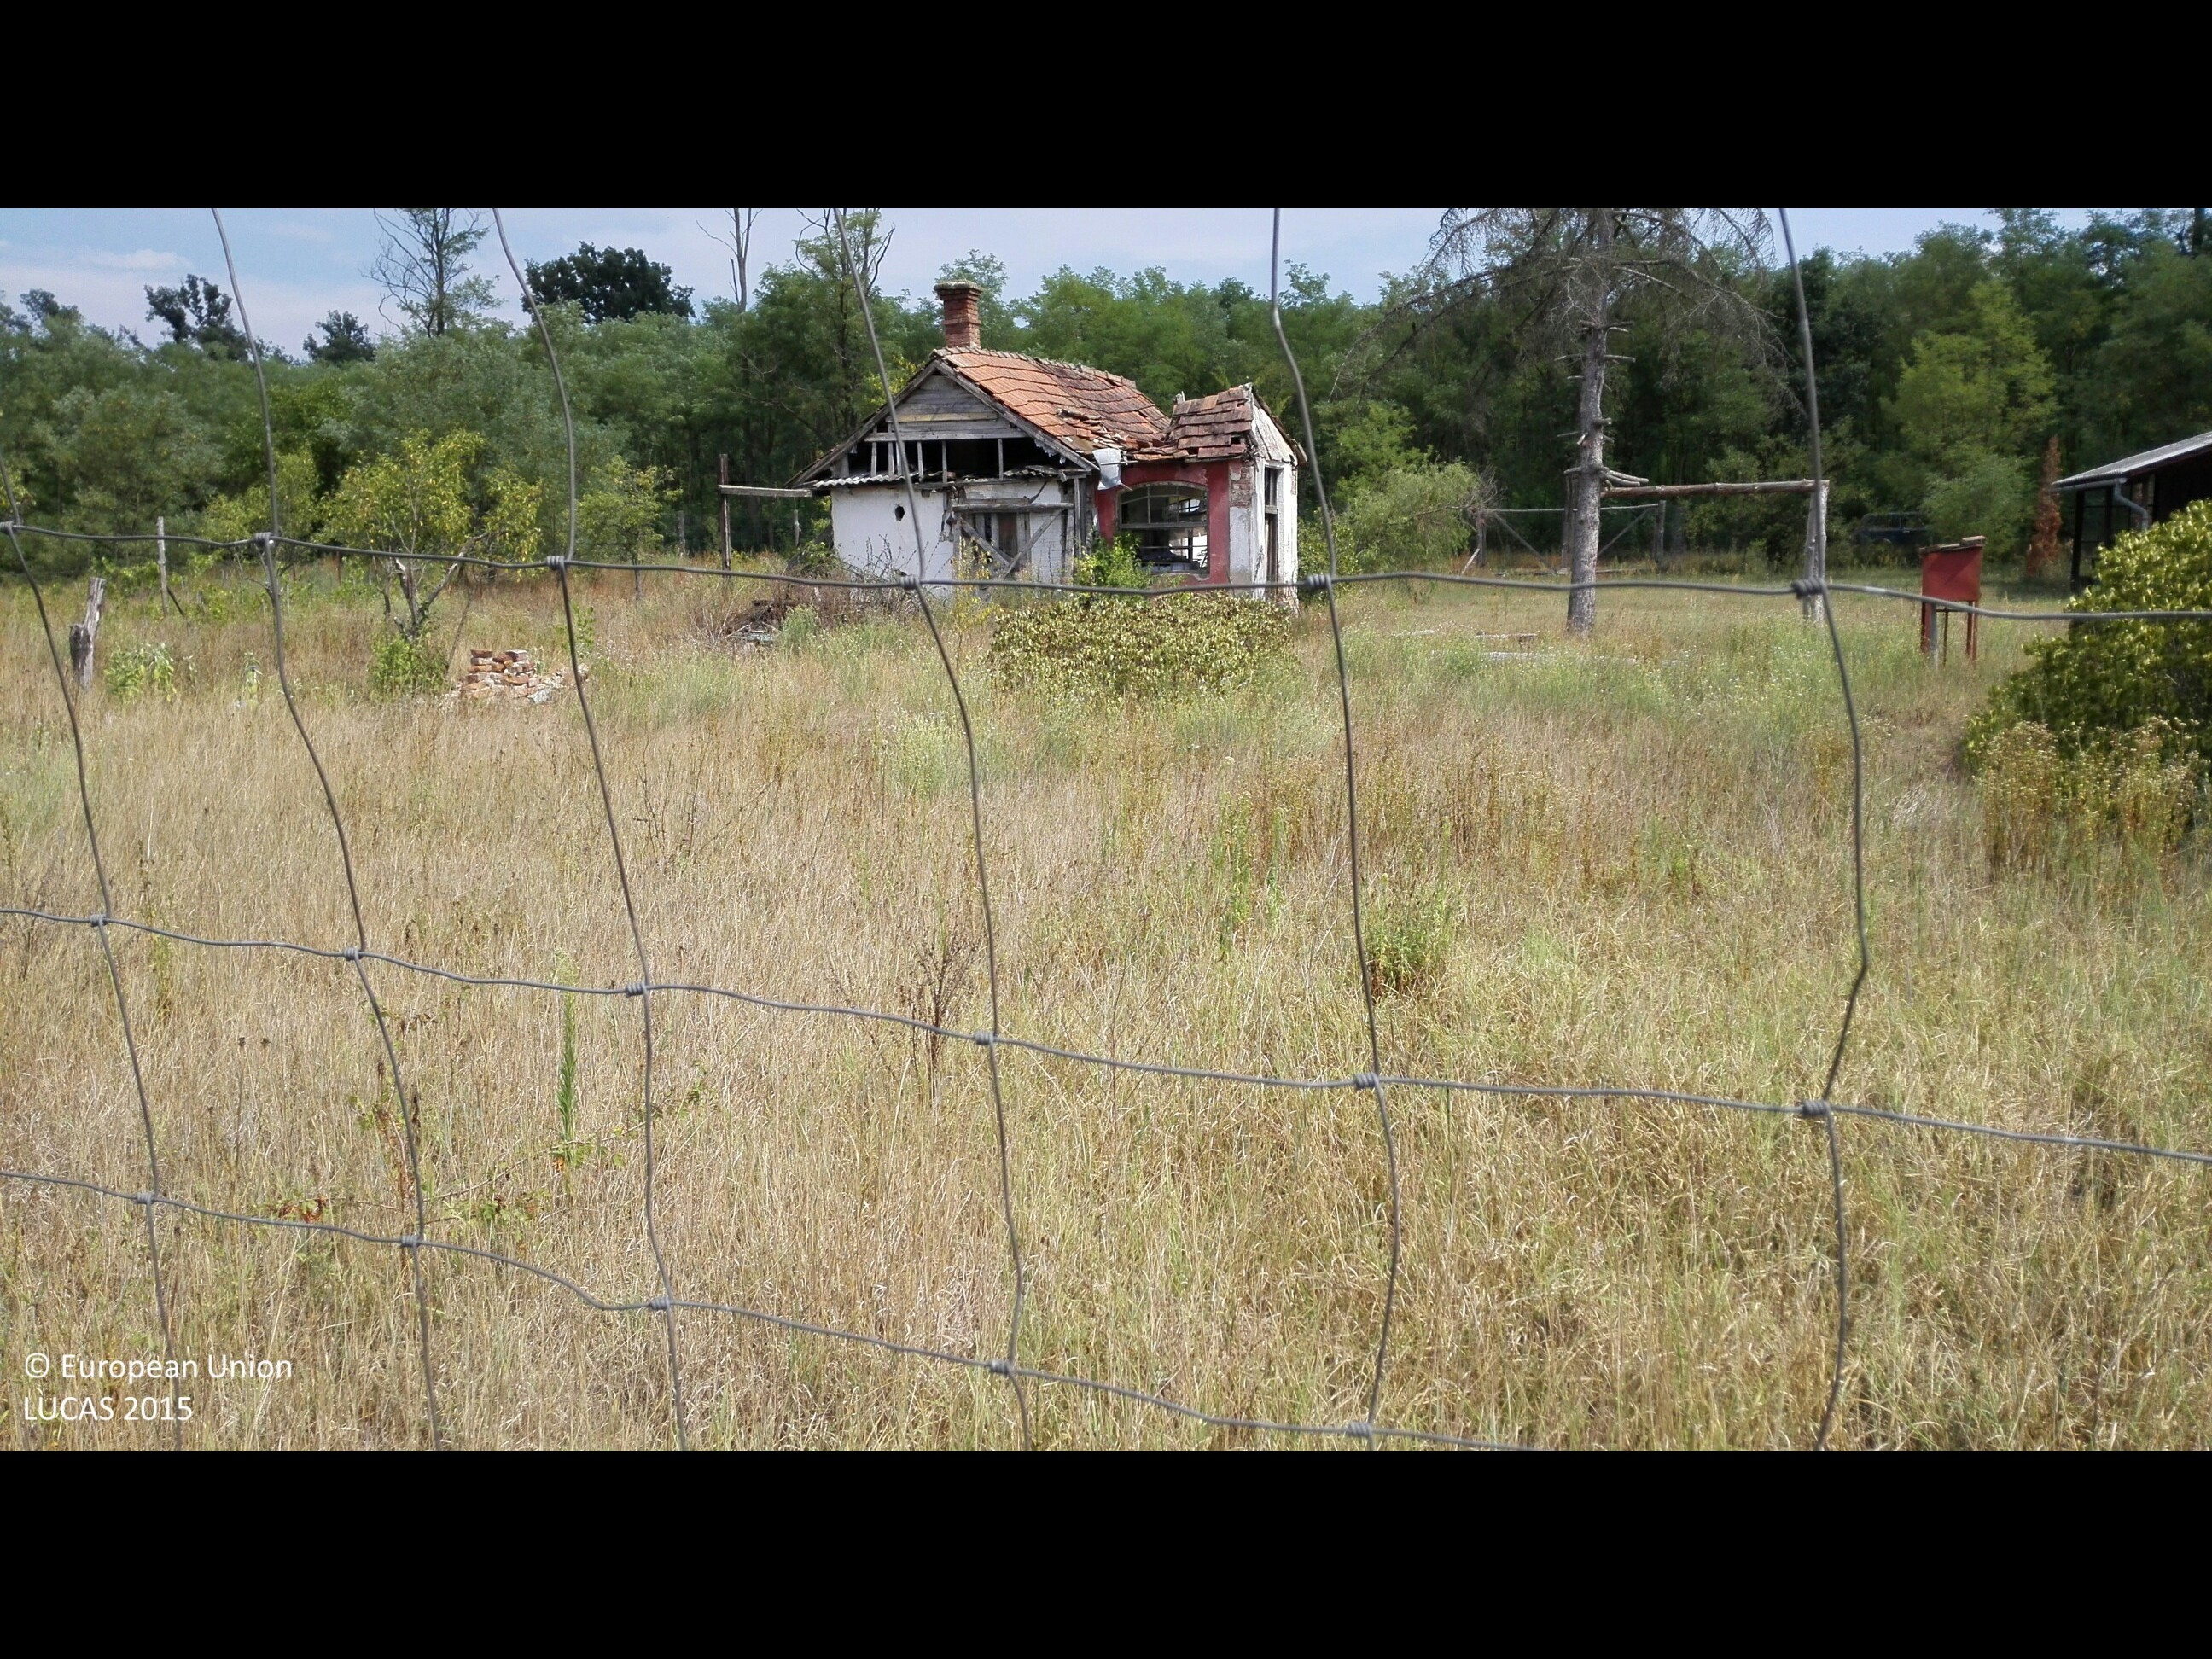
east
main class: Grassland
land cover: Grassland with sparse tree/shrub cover
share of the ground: > 75 %
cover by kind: herbaceous plants 90 %, broadleaved forest trees 5 %, shrubs 5 %
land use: Residential
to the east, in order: Grassland with sparse tree/shrub cover; Fences; Grass margins; Tracks; Broadleaved woodland; Pine dominated coniferous woodland; Grassland with sparse tree/shrub cover
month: August
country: HU
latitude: 47.5650
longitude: 21.8373
